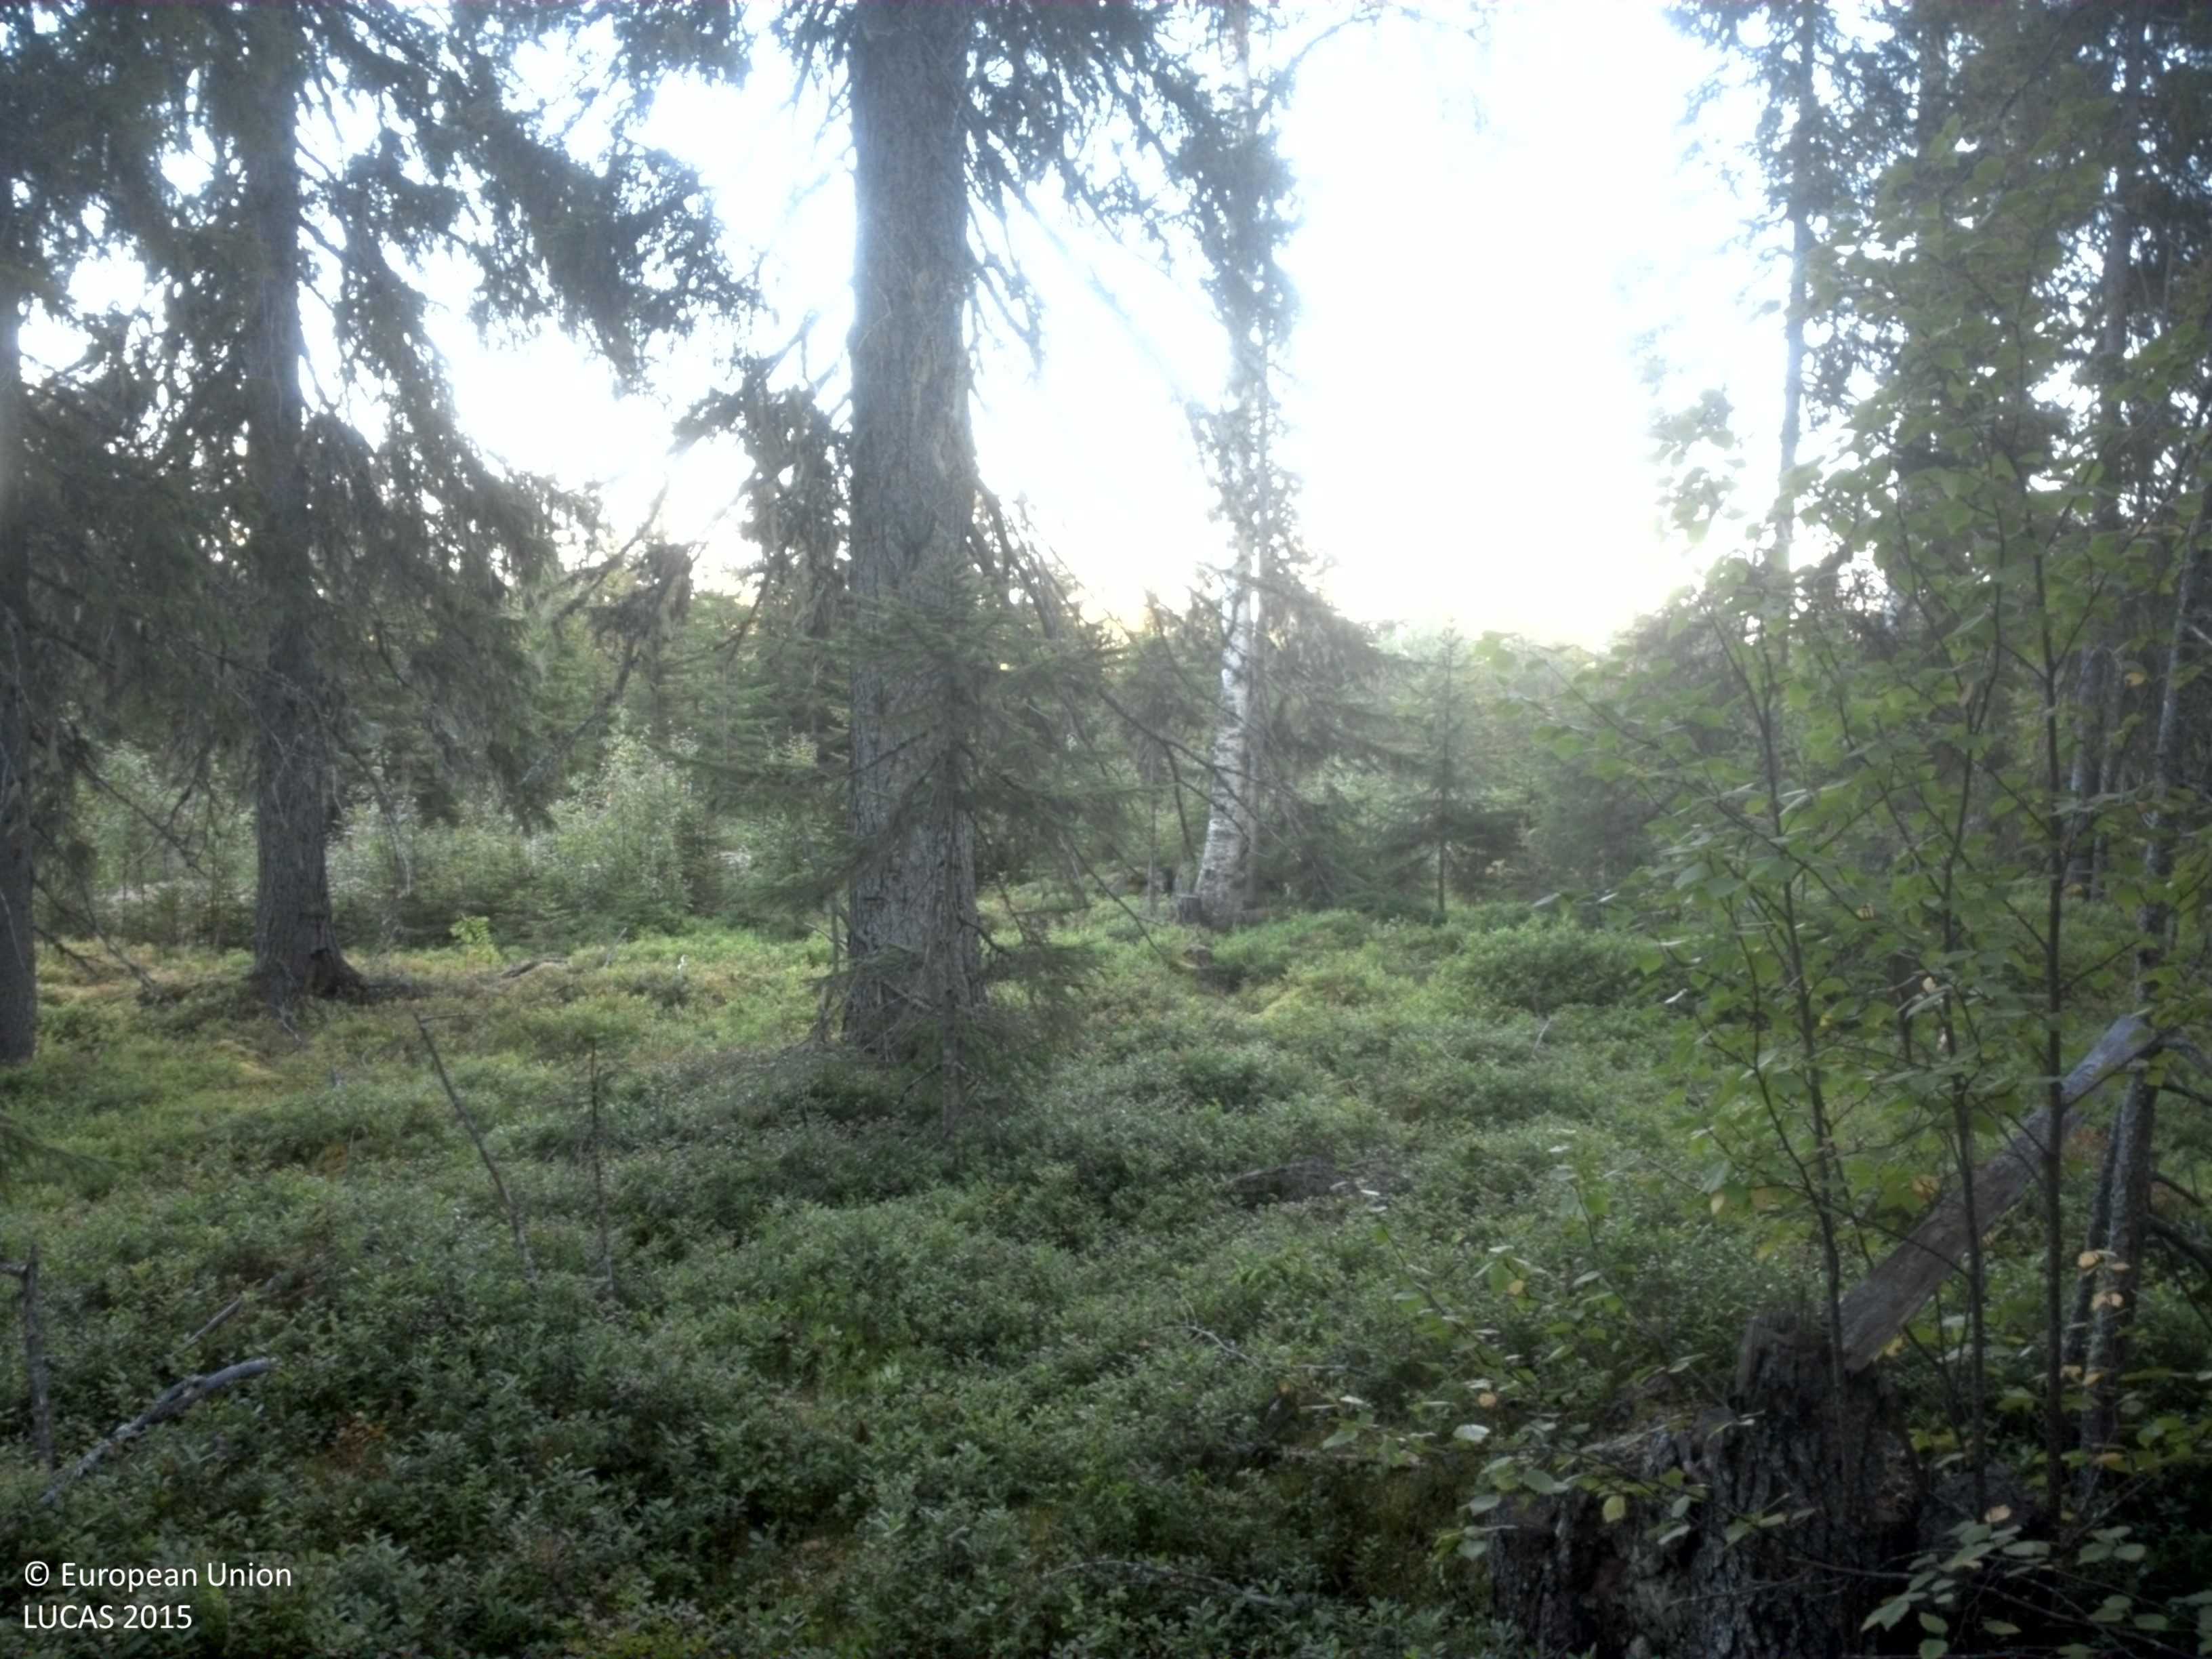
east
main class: Woodland
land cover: Spruce dominated coniferous woodland
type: boreal forest
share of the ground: 50 - 75 %
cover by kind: coniferous forest trees 60 %, shrubs 40 %
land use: Forestry
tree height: > 5 m
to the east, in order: Spruce dominated coniferous woodland; Broadleaved woodland; Ditches and canals; Shruby margins; Paved roads, cycling and walking lanes; Shruby margins; Spruce dominated coniferous woodland; Spruce dominated mixed woodland; Spruce dominated coniferous woodland; Pine dominated mixed woodland; Ditches and canals; Pine dominated mixed woodland
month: September
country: SE
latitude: 64.7134
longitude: 19.8118
